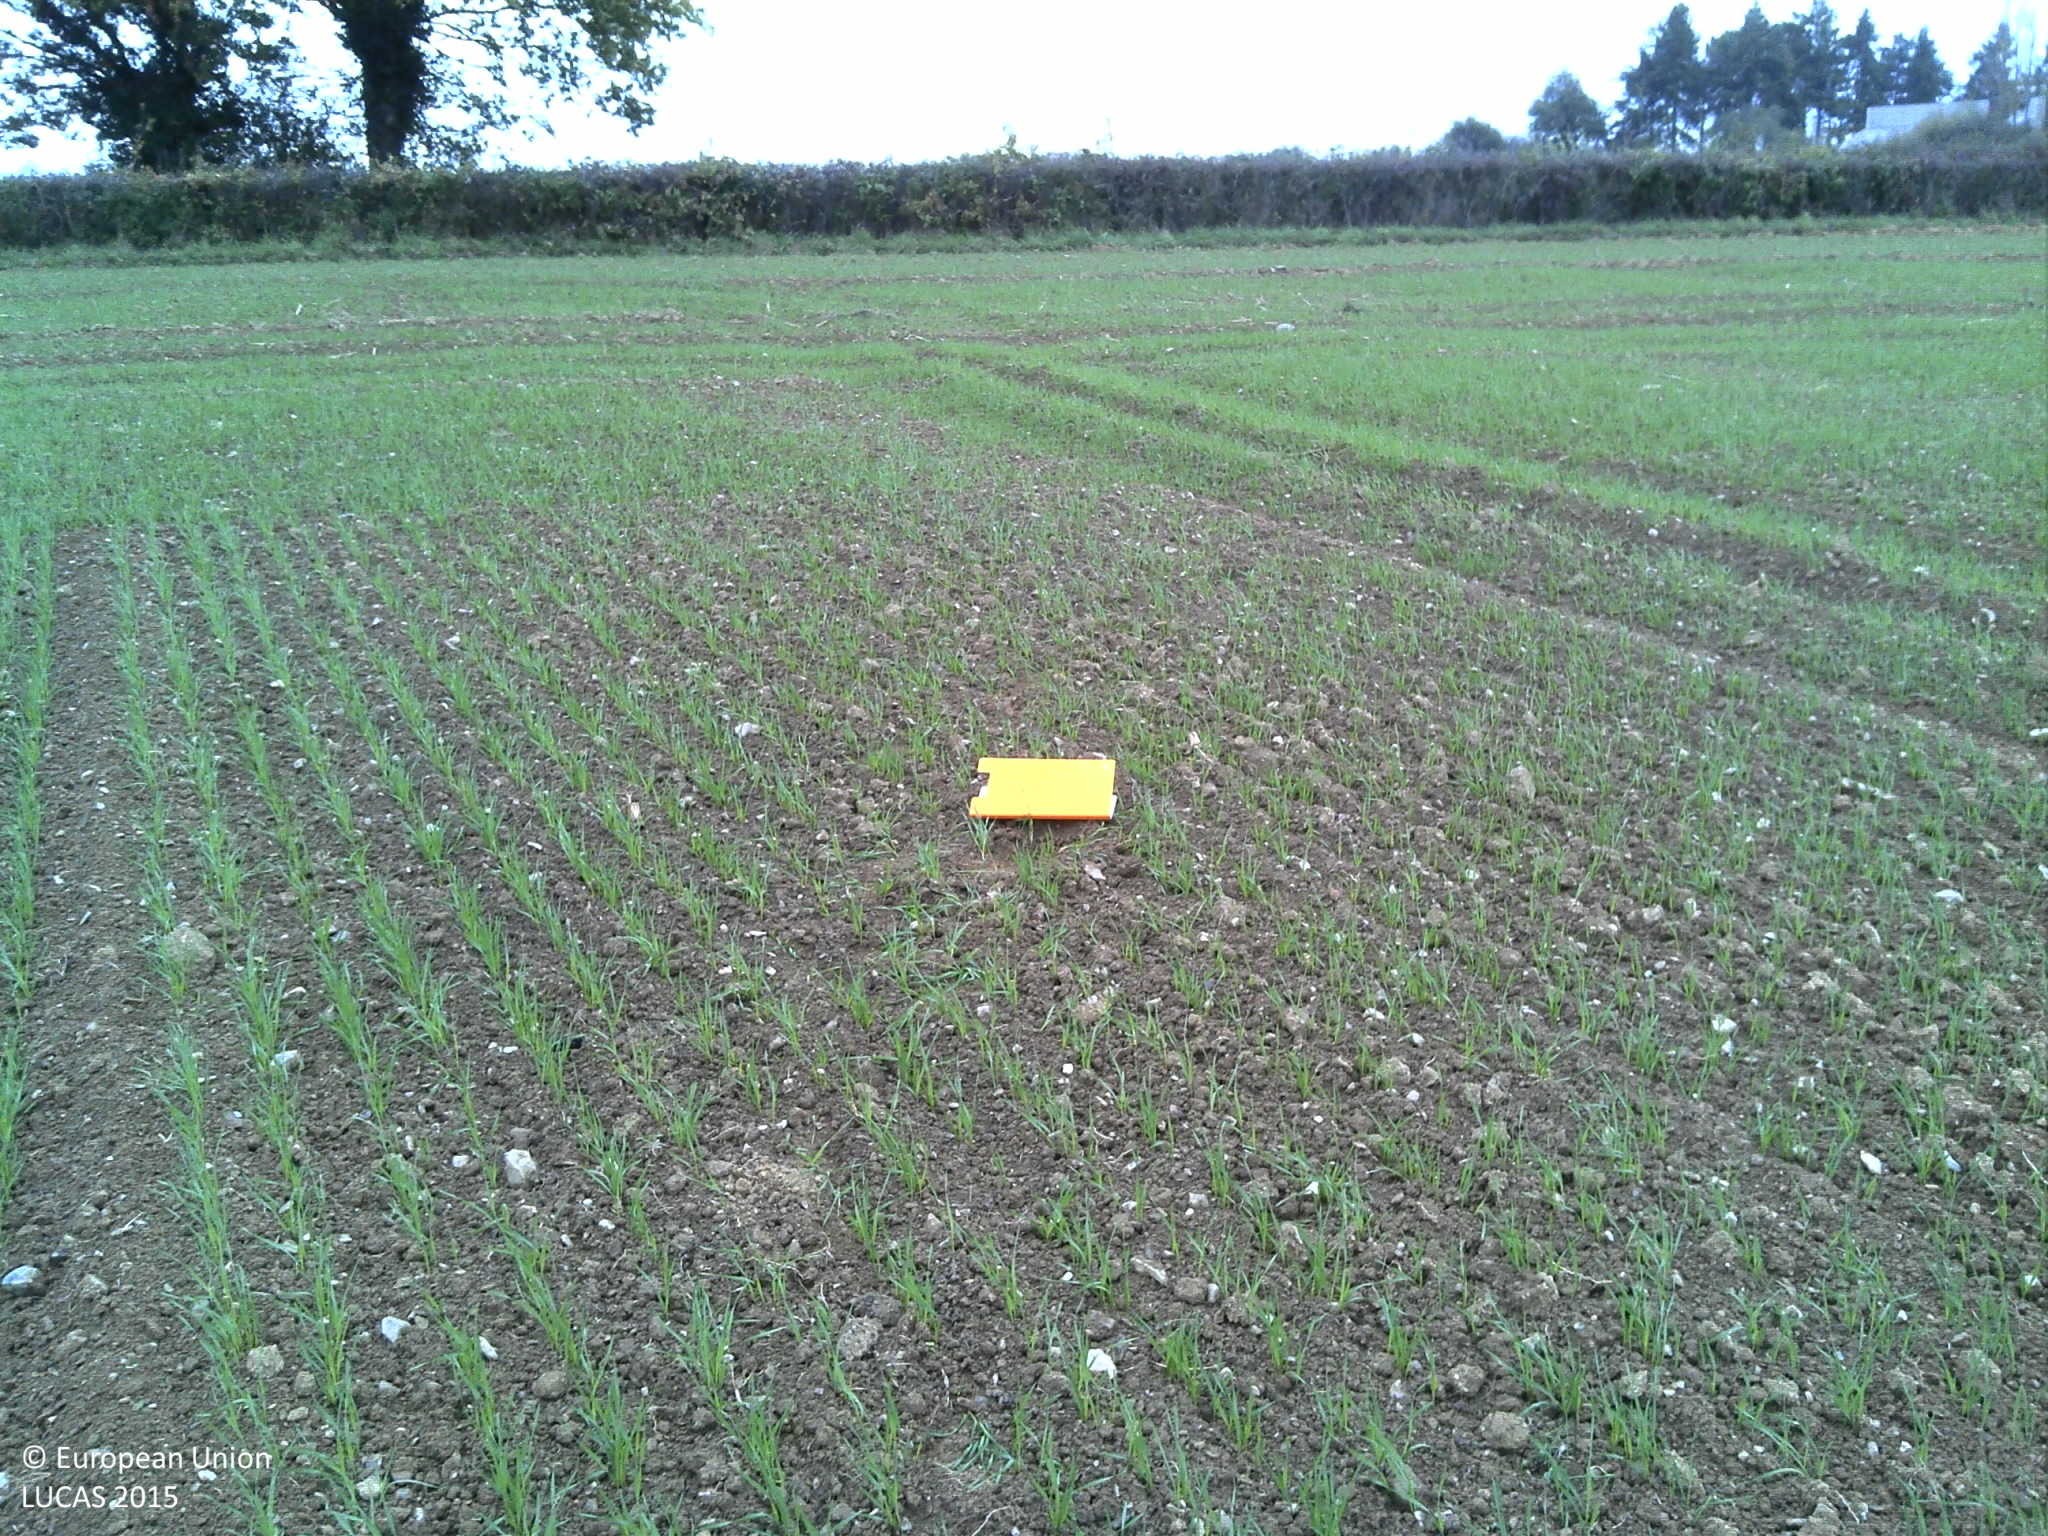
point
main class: Cropland
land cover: Common wheat
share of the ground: < 10 %
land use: Agriculture (excluding fallow land and kitchen gardens)
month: November
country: FR
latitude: 47.4559
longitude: -1.3282
